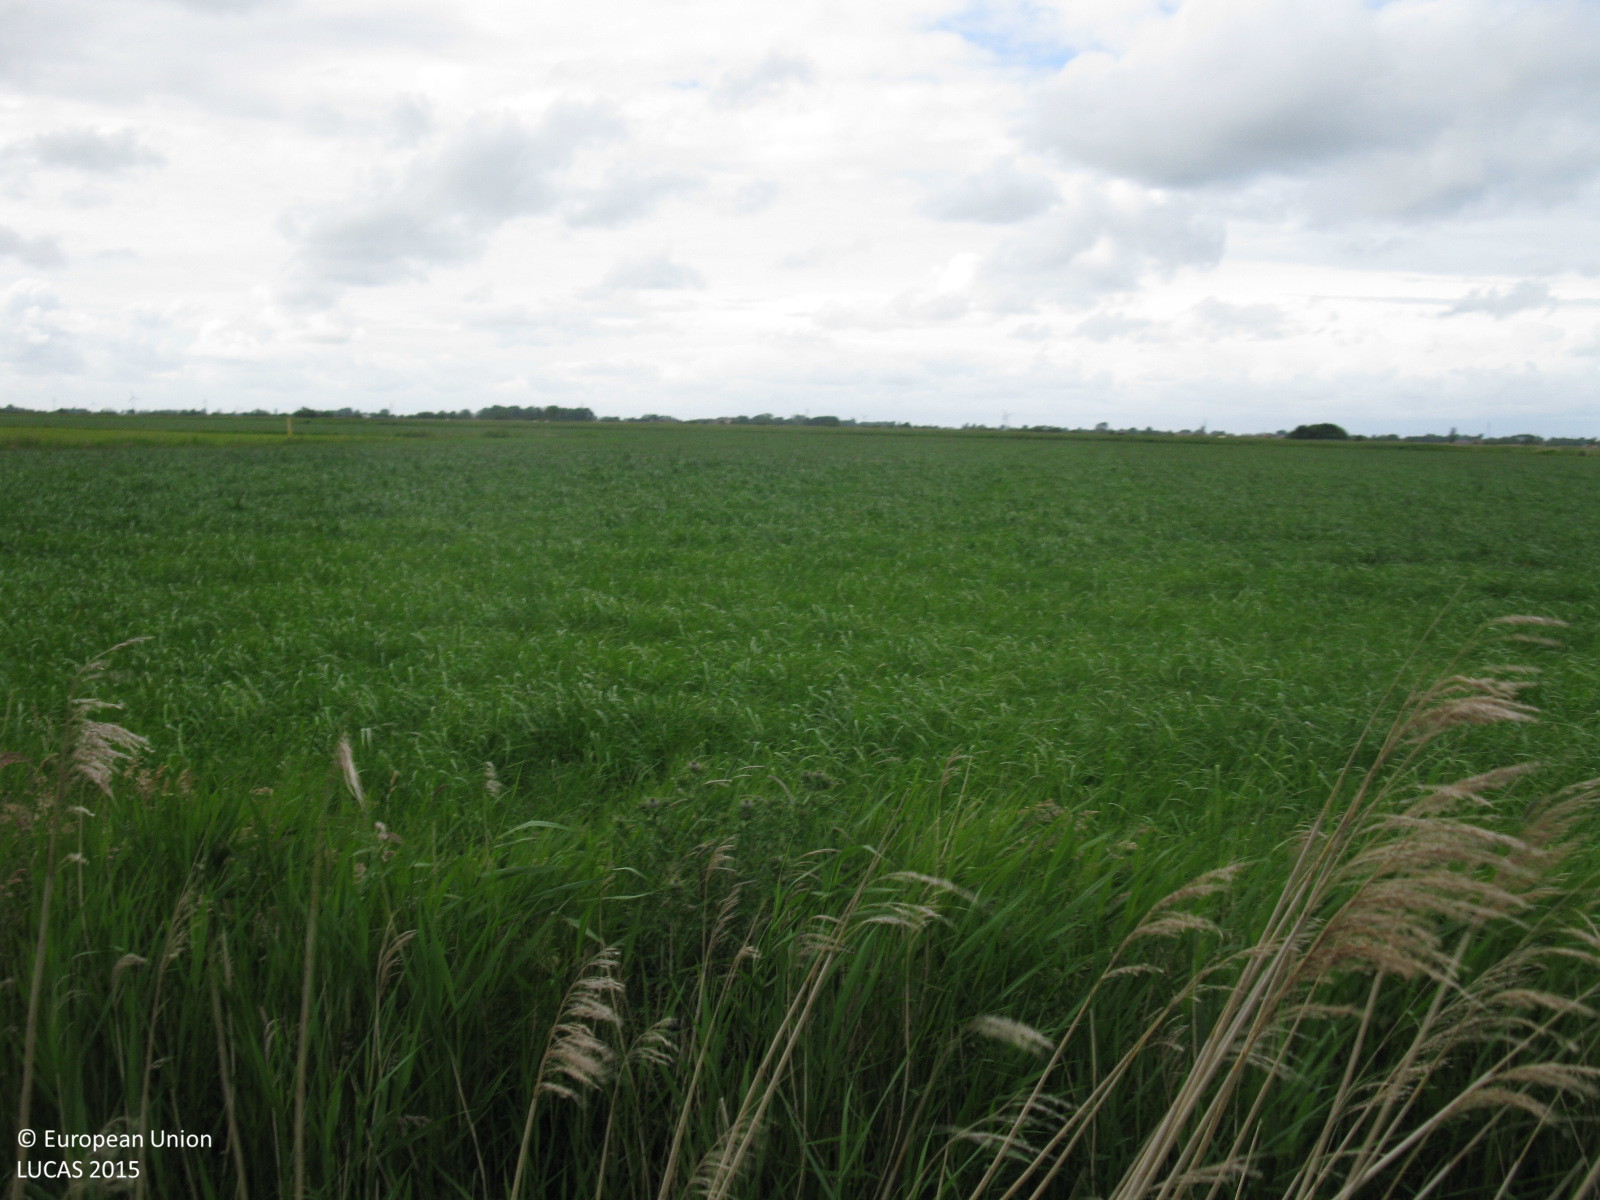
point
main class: Cropland
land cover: Temporary grasslands
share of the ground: > 75 %
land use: Agriculture (excluding fallow land and kitchen gardens)
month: June
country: DE
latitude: 53.6255
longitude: 7.3849
